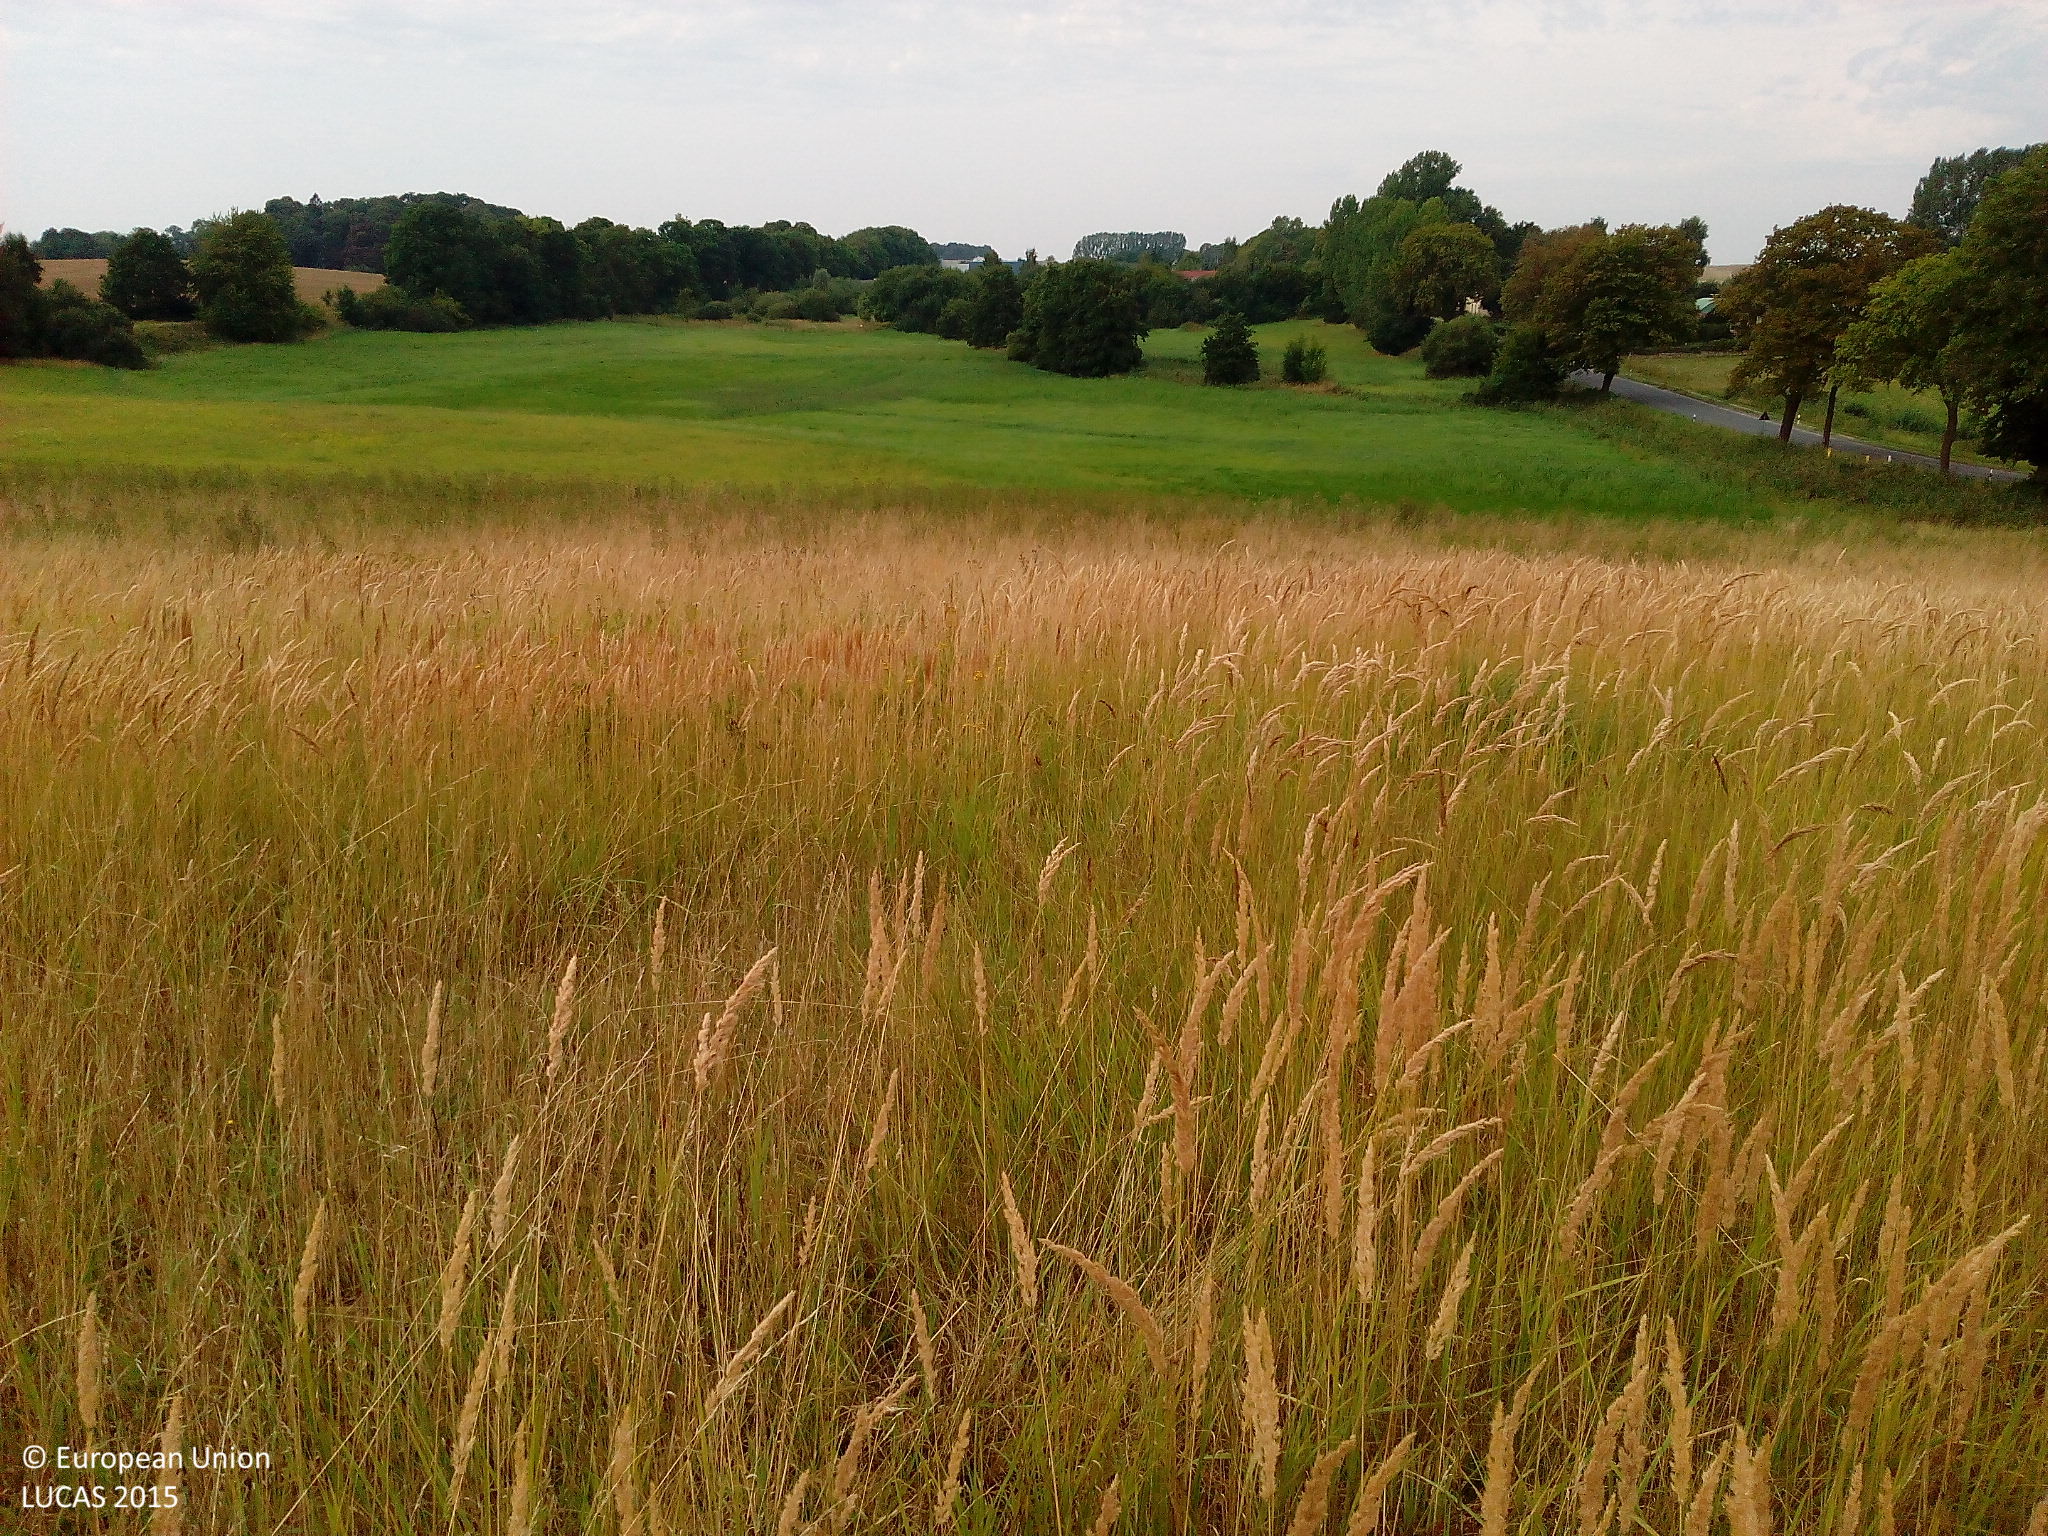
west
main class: Grassland
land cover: Grassland without tree/shrub cover
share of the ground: > 75 %
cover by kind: herbaceous plants 100 %
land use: Agriculture (excluding fallow land and kitchen gardens)
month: August
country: DE
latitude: 54.1104
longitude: 12.6453
